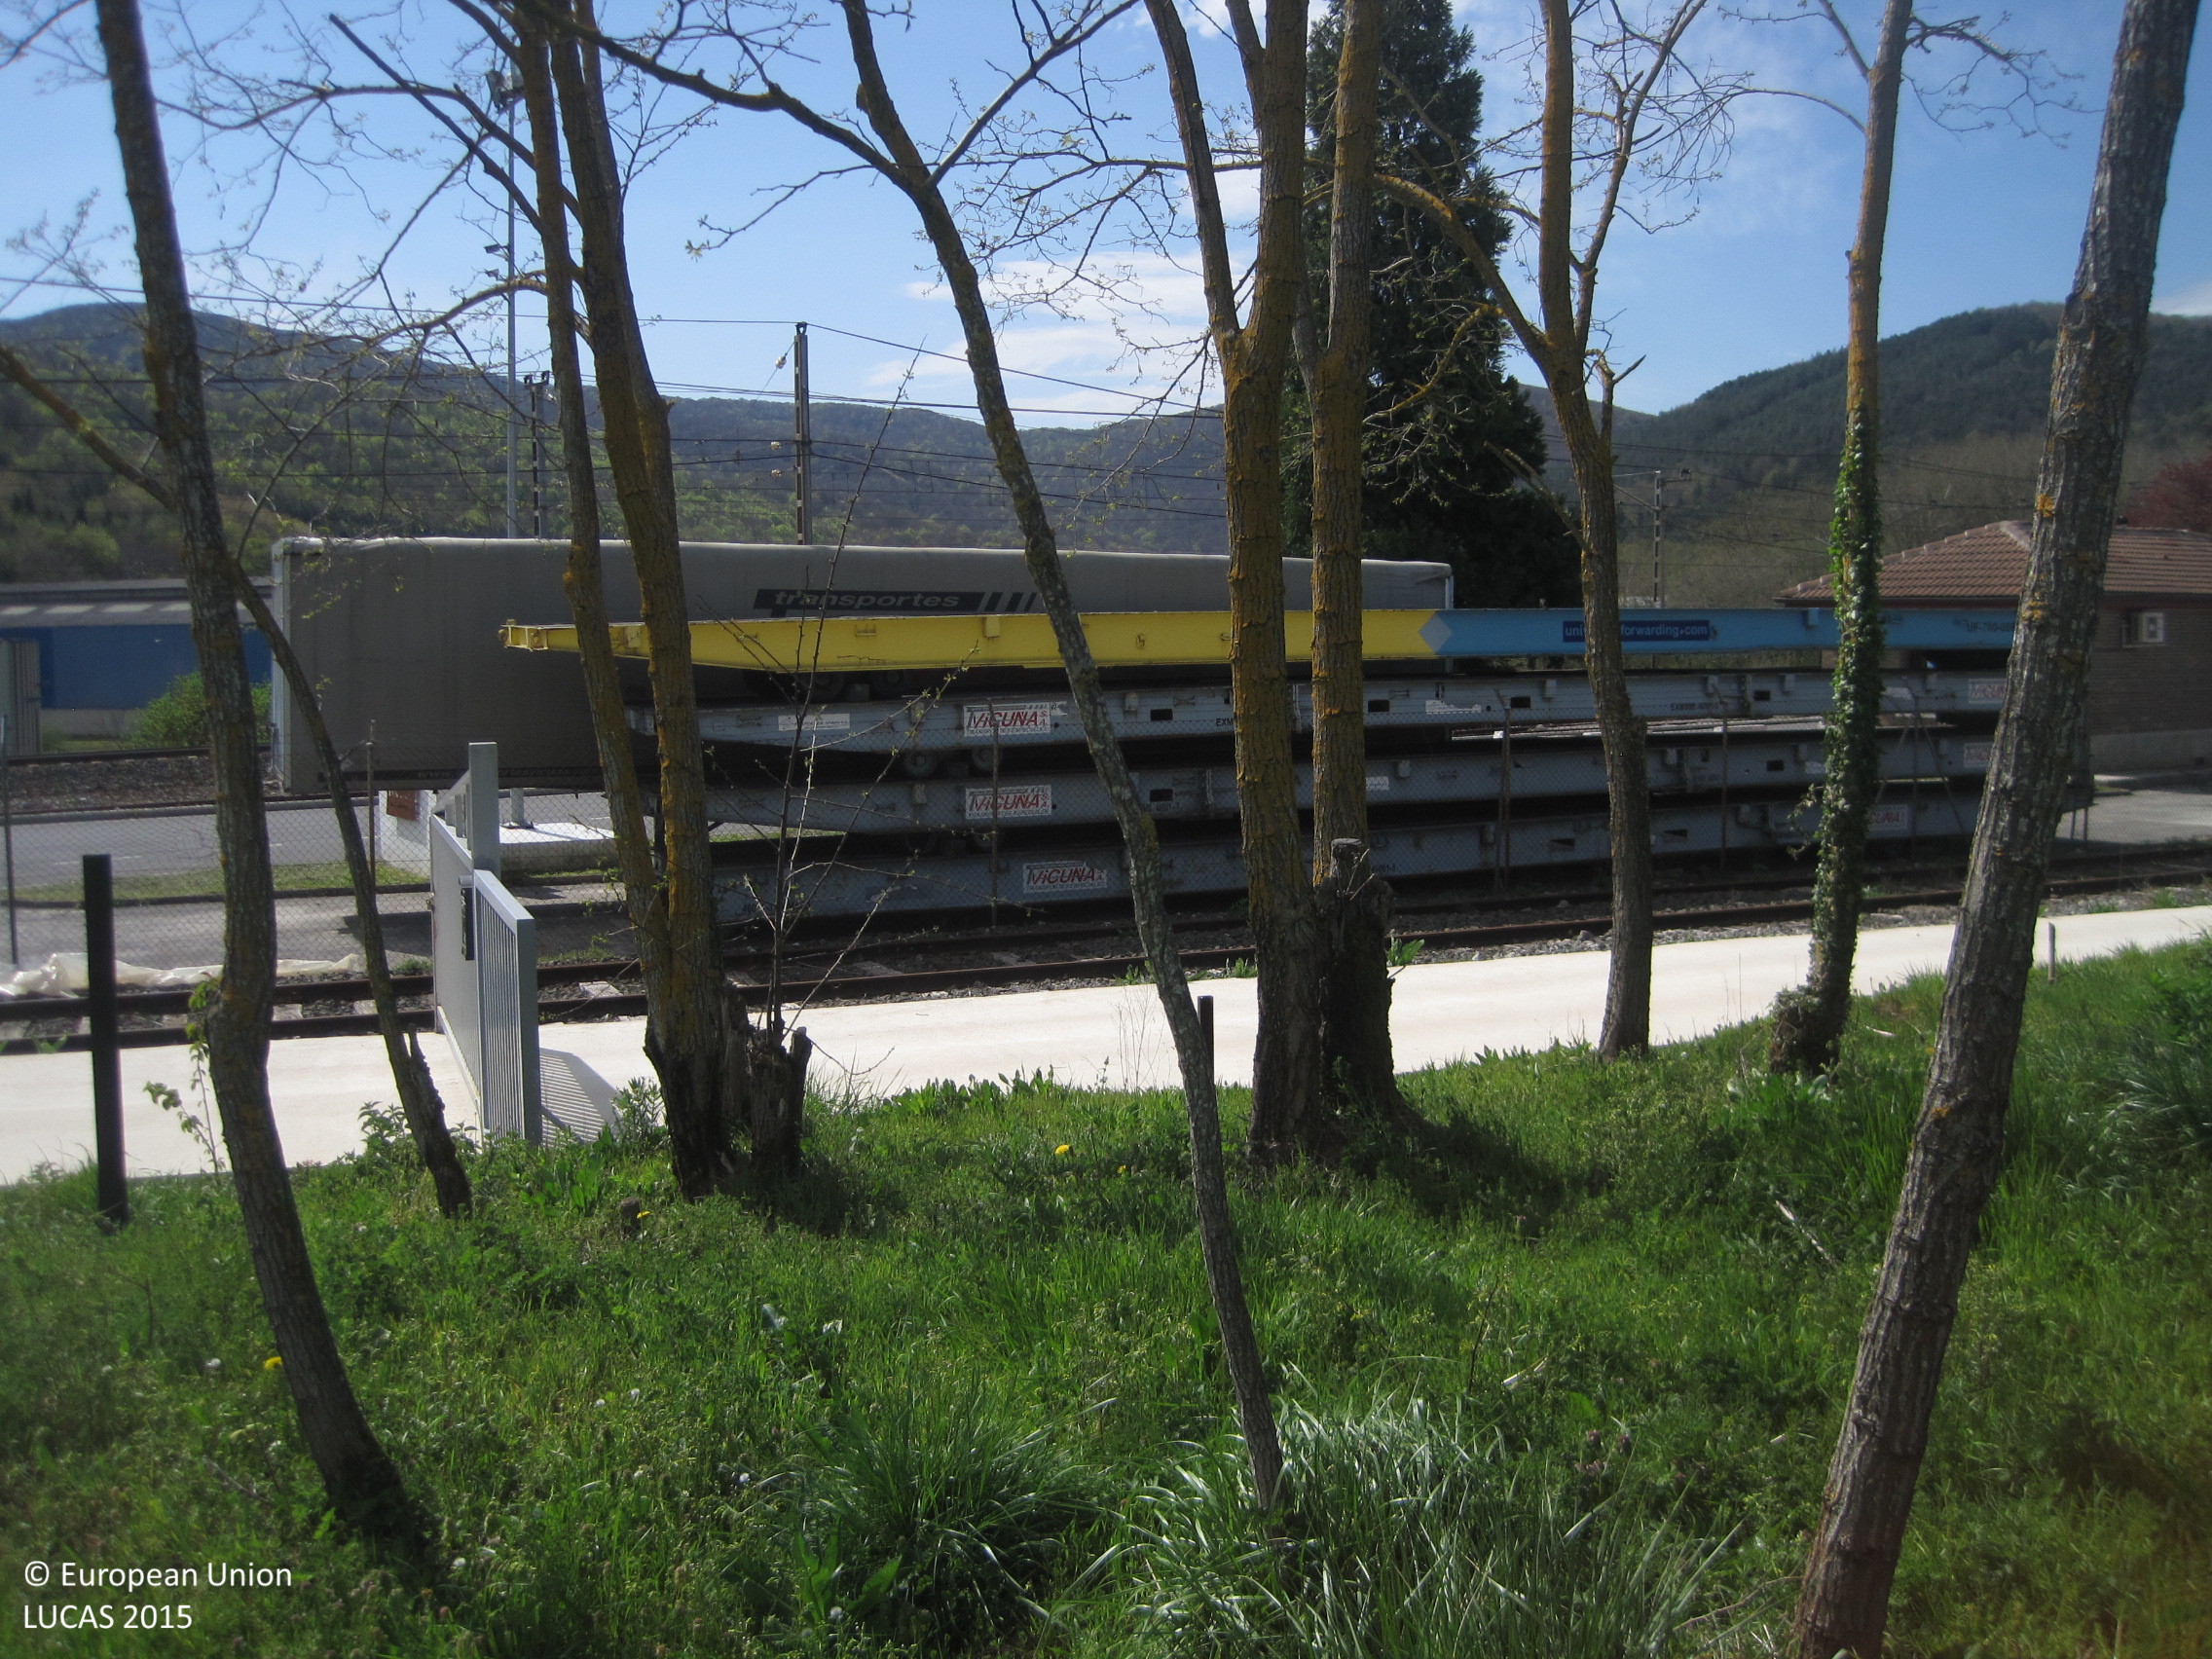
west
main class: Grassland
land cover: Grassland without tree/shrub cover
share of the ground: > 75 %
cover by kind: herbaceous plants 100 %
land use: Agriculture (excluding fallow land and kitchen gardens)
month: April
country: ES
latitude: 42.9006
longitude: -2.1826
